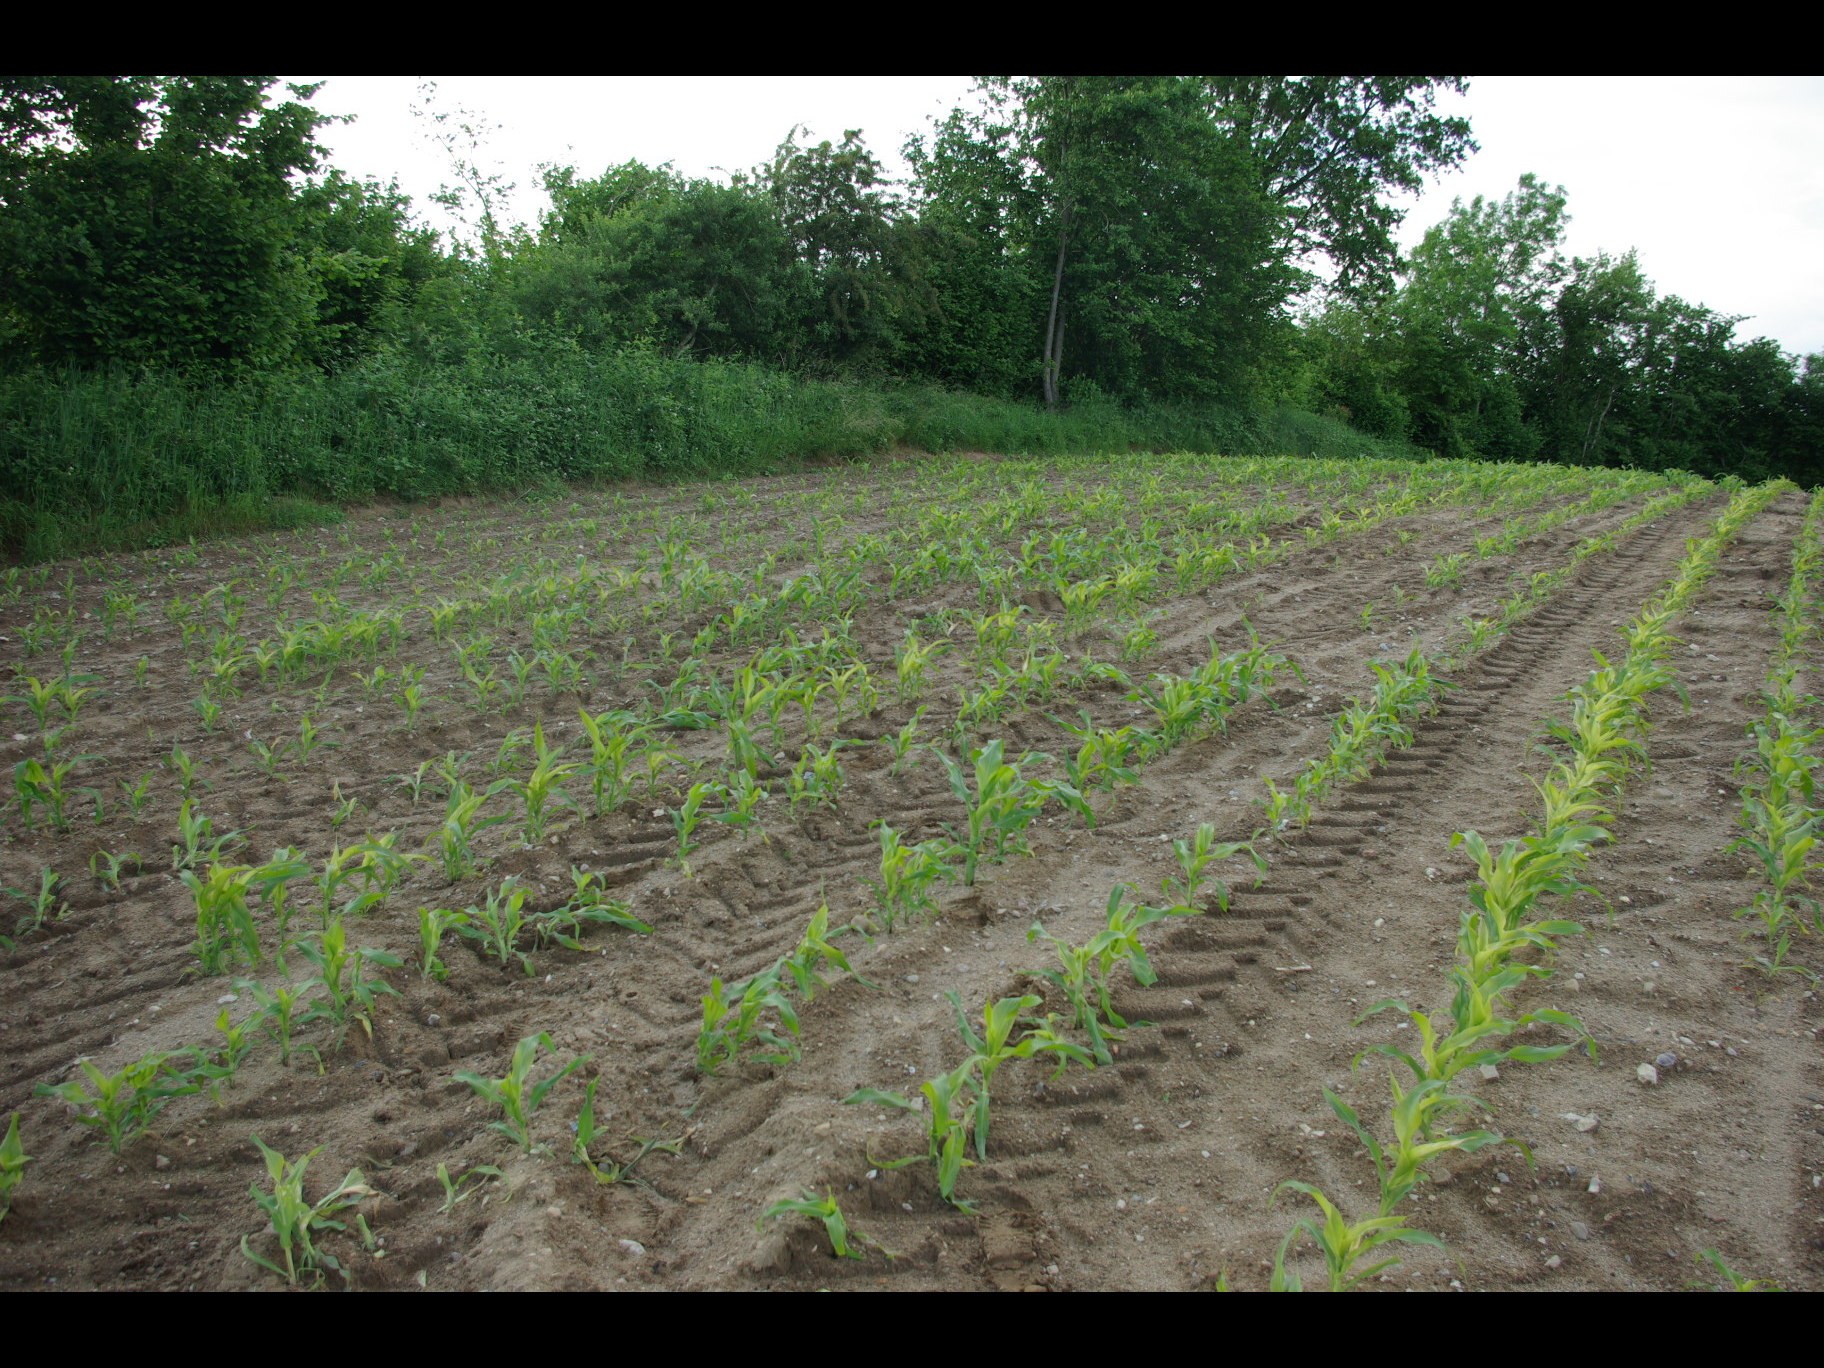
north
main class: Cropland
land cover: Maize
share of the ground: 10 - 25 %
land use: Agriculture (excluding fallow land and kitchen gardens)
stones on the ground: > 50 %
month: June
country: DE
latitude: 54.2286
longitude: 9.9233
